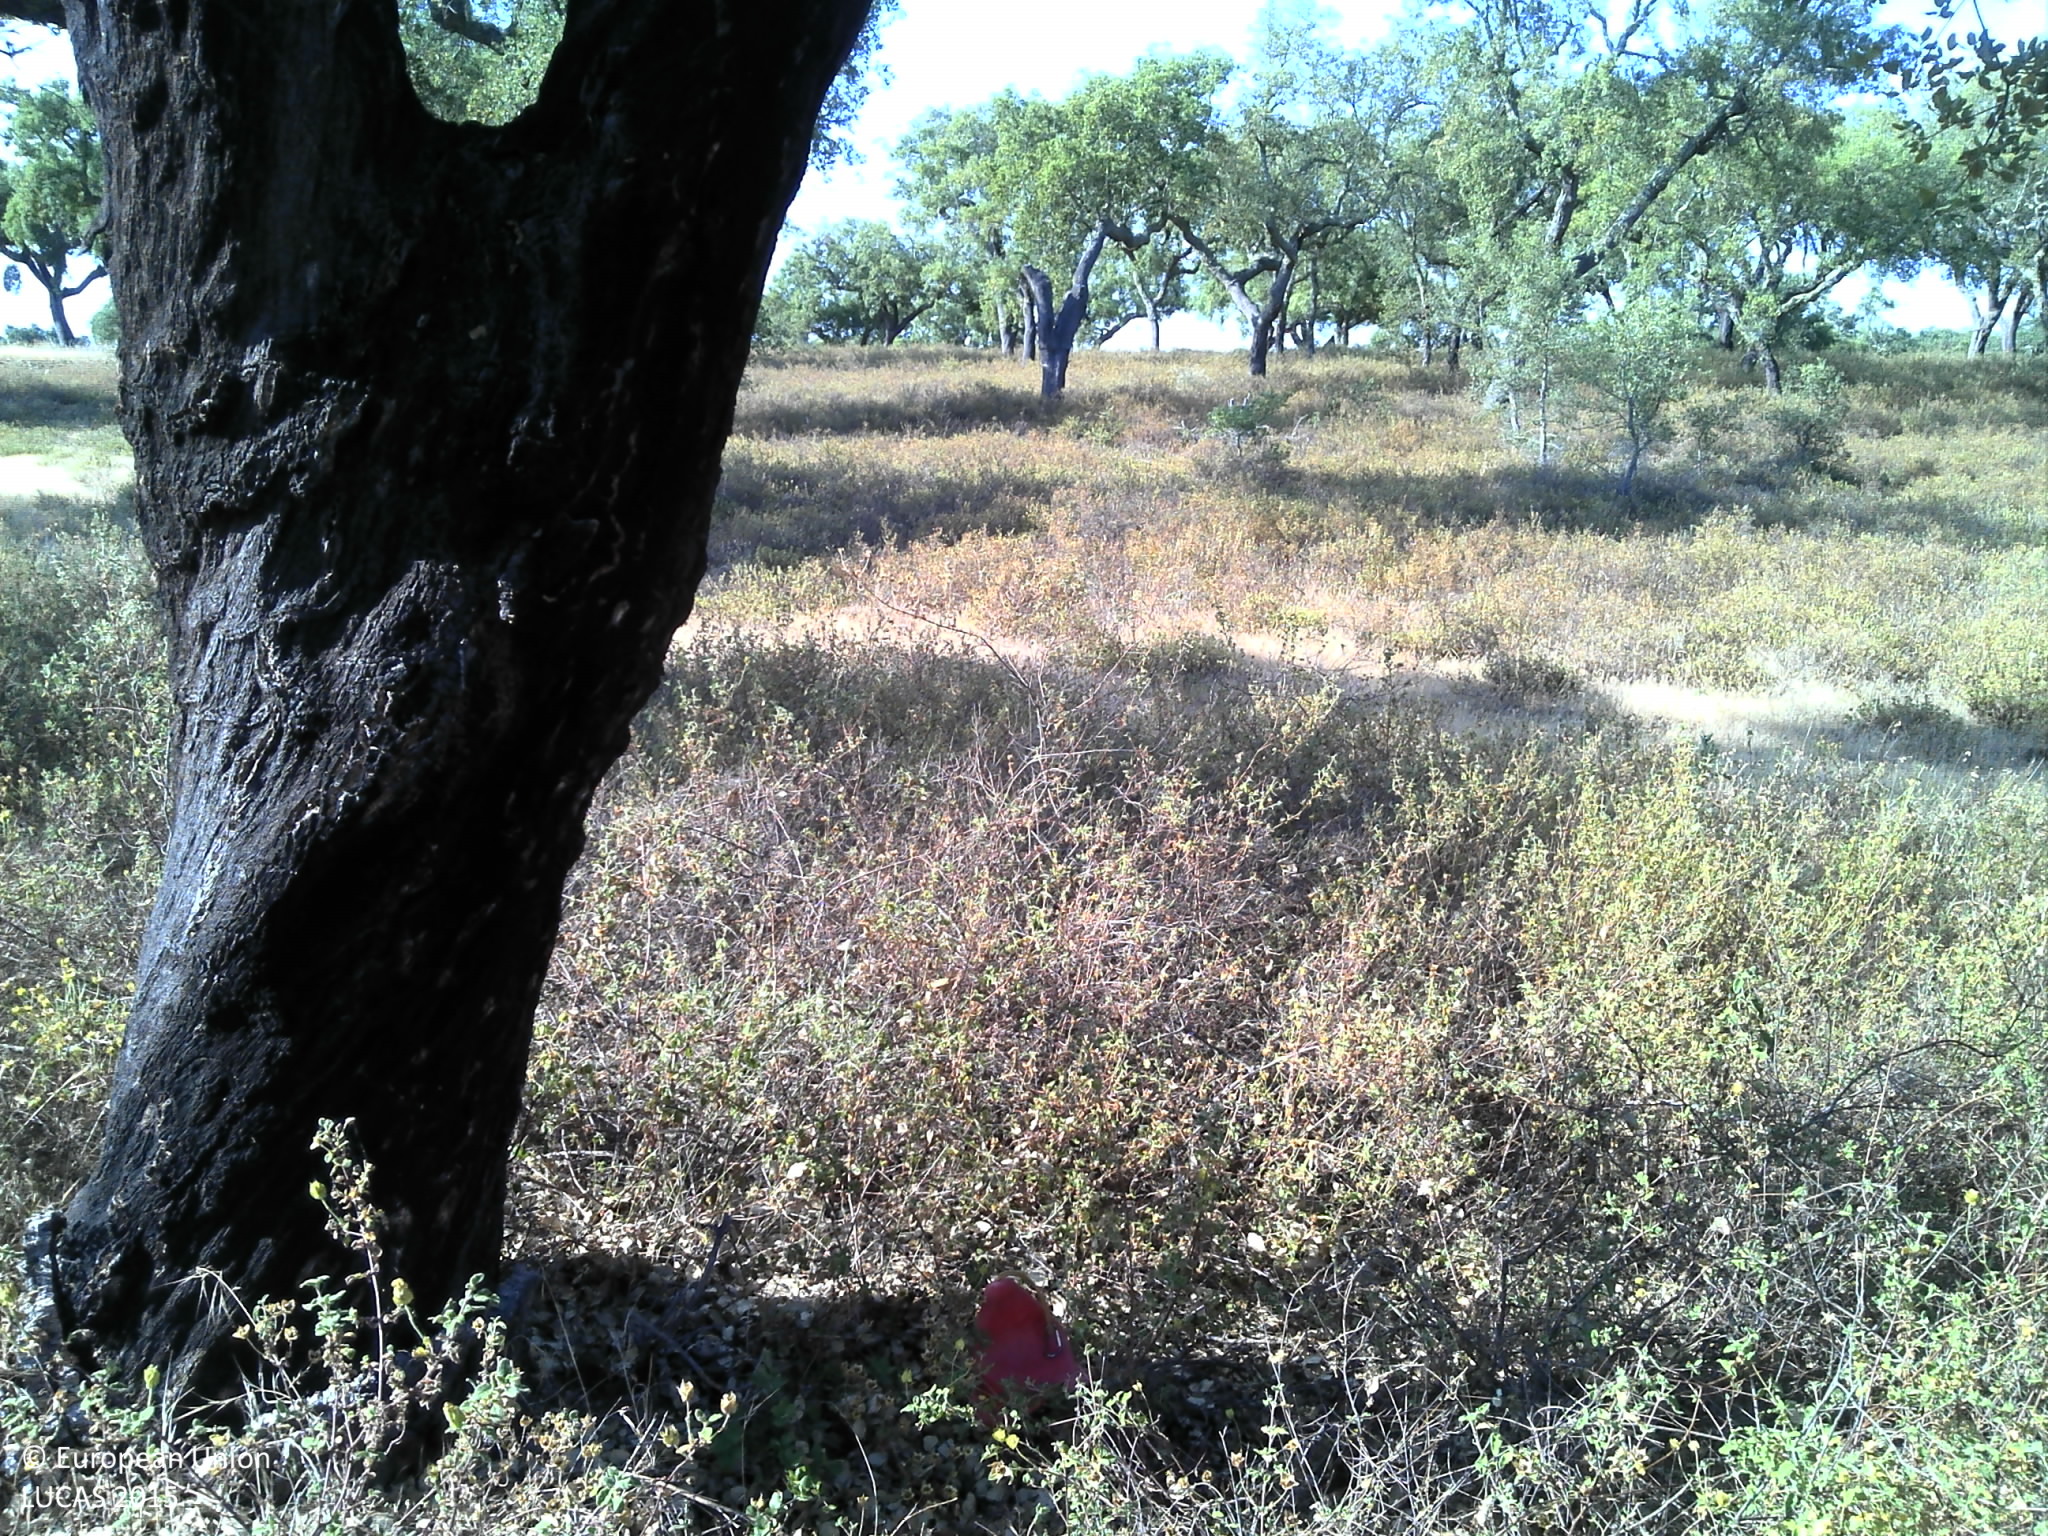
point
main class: Woodland
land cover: Broadleaved woodland
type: broadleaved evergreen forest
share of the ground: 25 - 50 %
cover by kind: broadleaved forest trees 50 %, shrubs 40 %, herbaceous plants 10 %
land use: Forestry
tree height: > 5 m
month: June
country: PT
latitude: 38.6979
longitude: -7.8037
